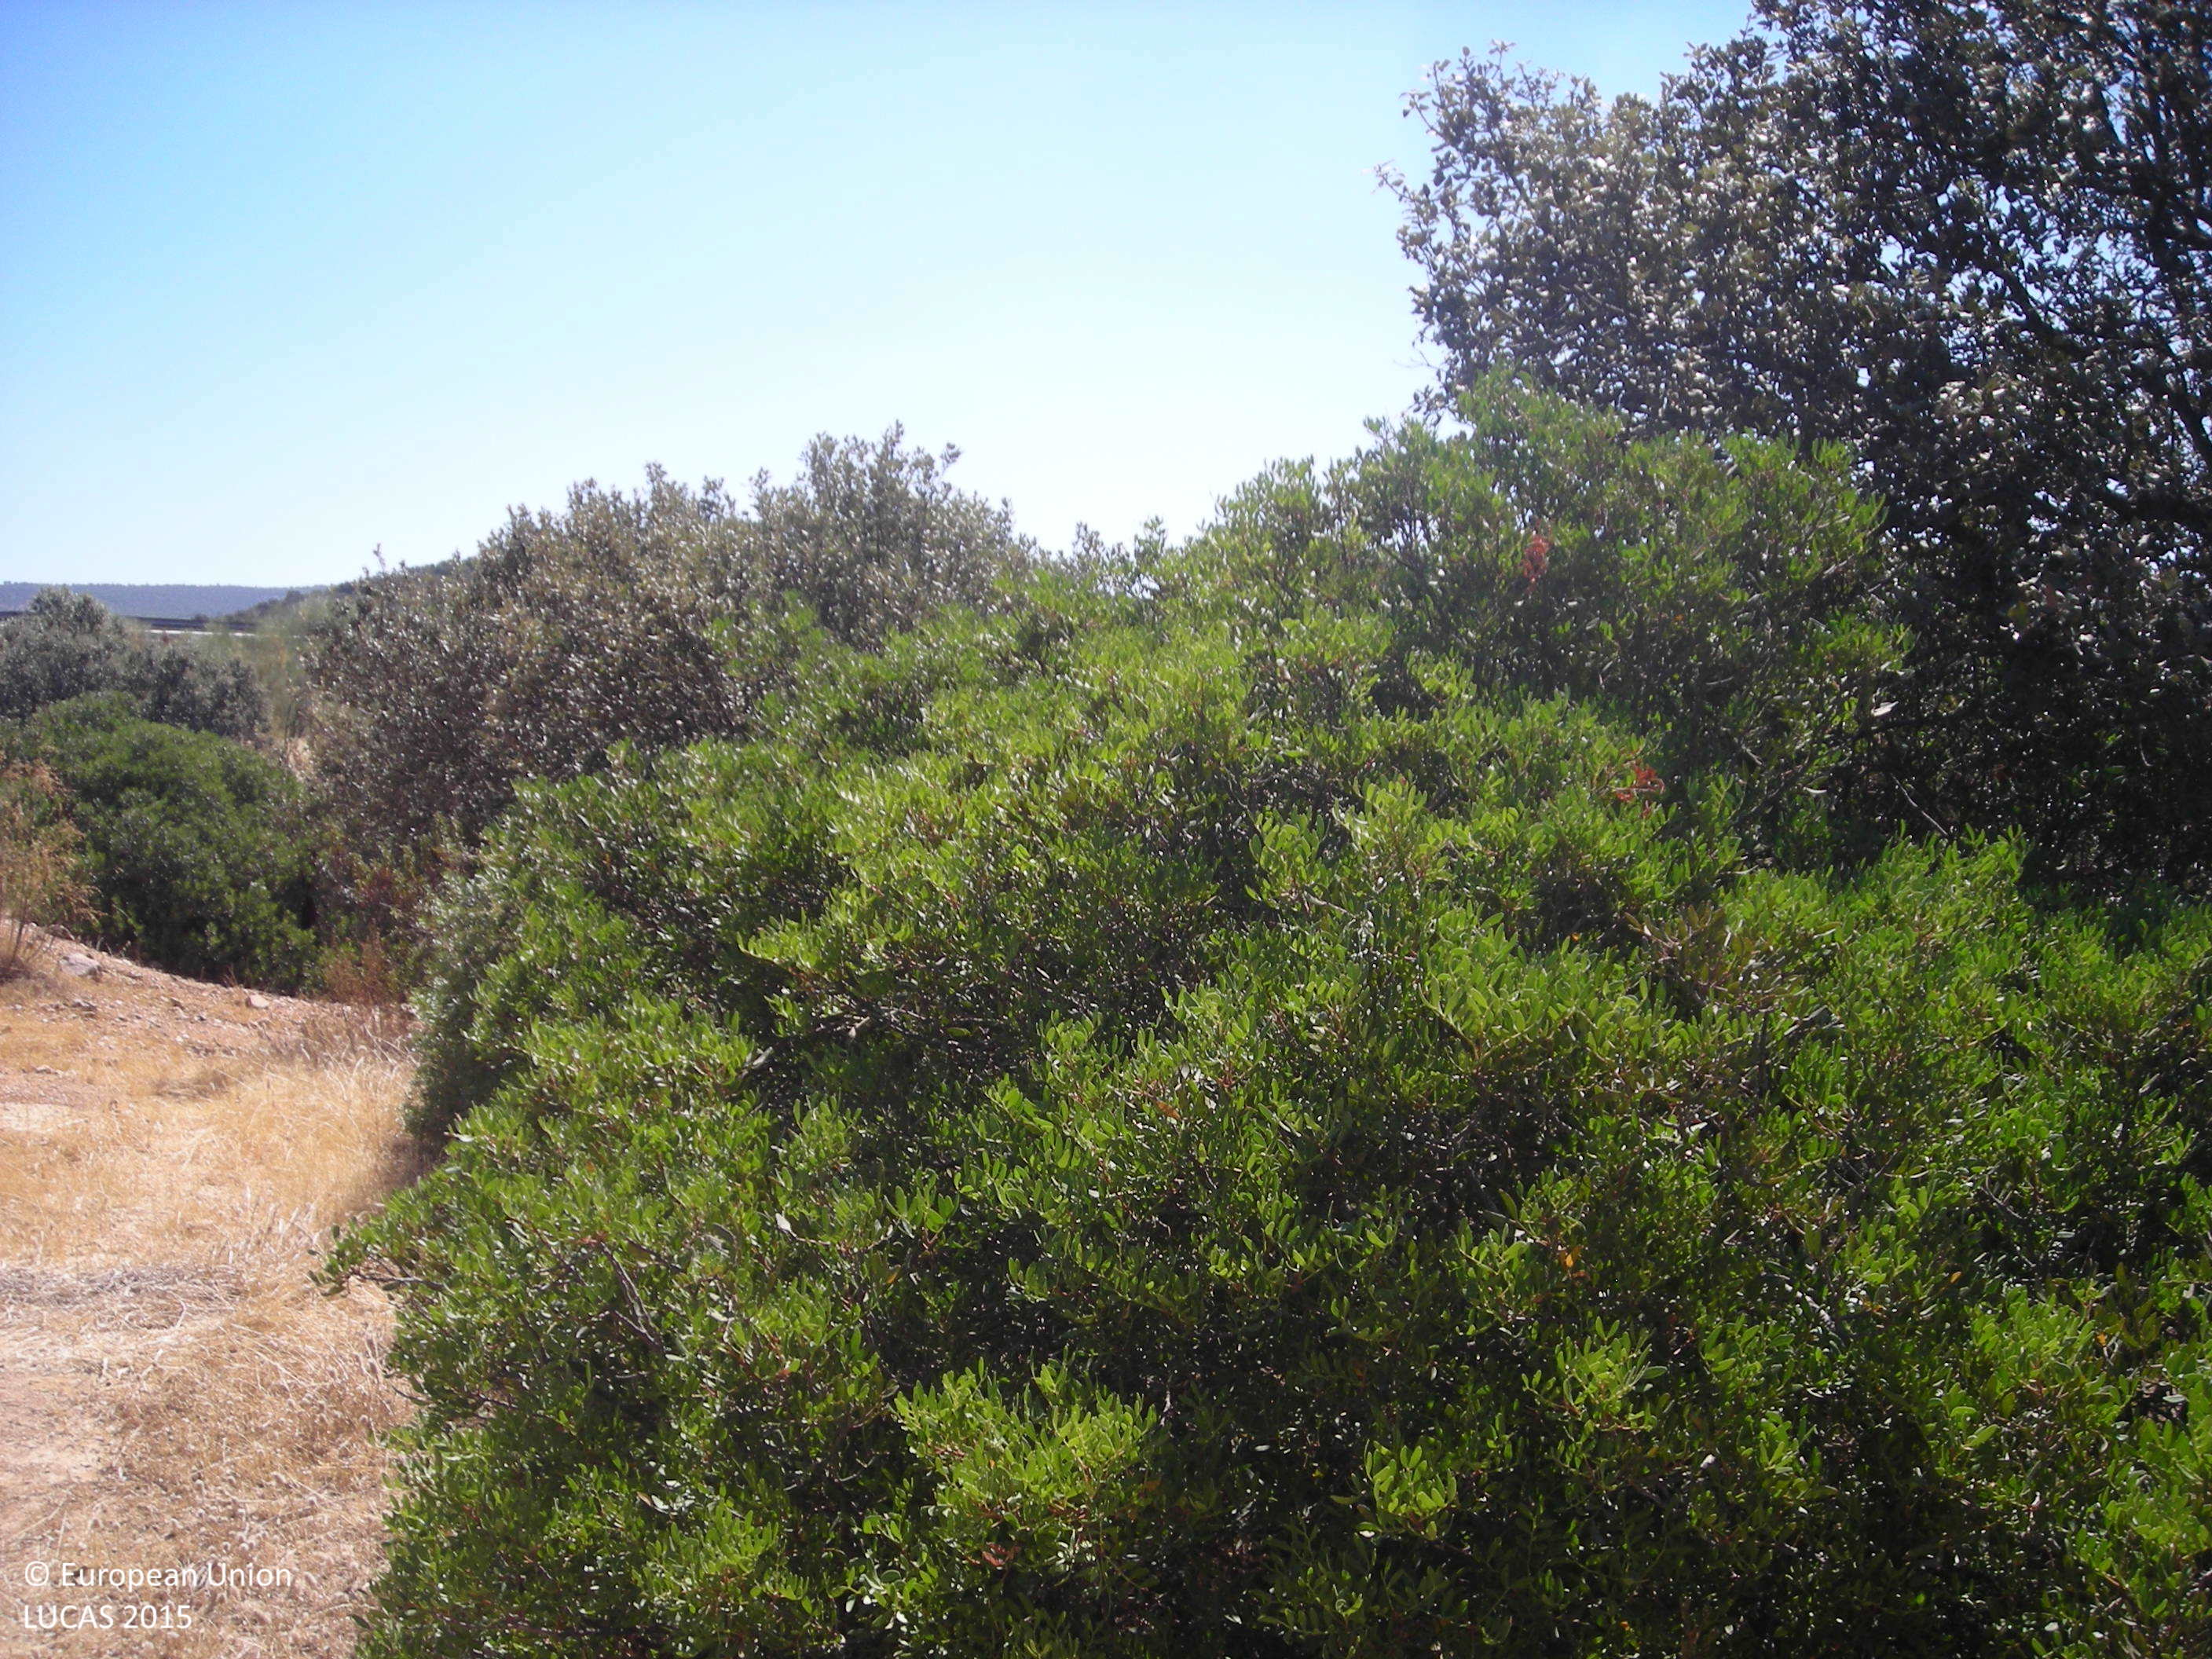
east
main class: Grassland
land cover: Grassland without tree/shrub cover
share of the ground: > 75 %
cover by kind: herbaceous plants 100 %
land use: Agriculture (excluding fallow land and kitchen gardens)
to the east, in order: Grassland without tree/shrub cover; Other bare soil; Shrubland with sparse tree cover; Rivers and streams; Shrubland with sparse tree cover; Other bare soil; Shrubland with sparse tree cover
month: July
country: ES
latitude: 38.7740
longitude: -5.9198
